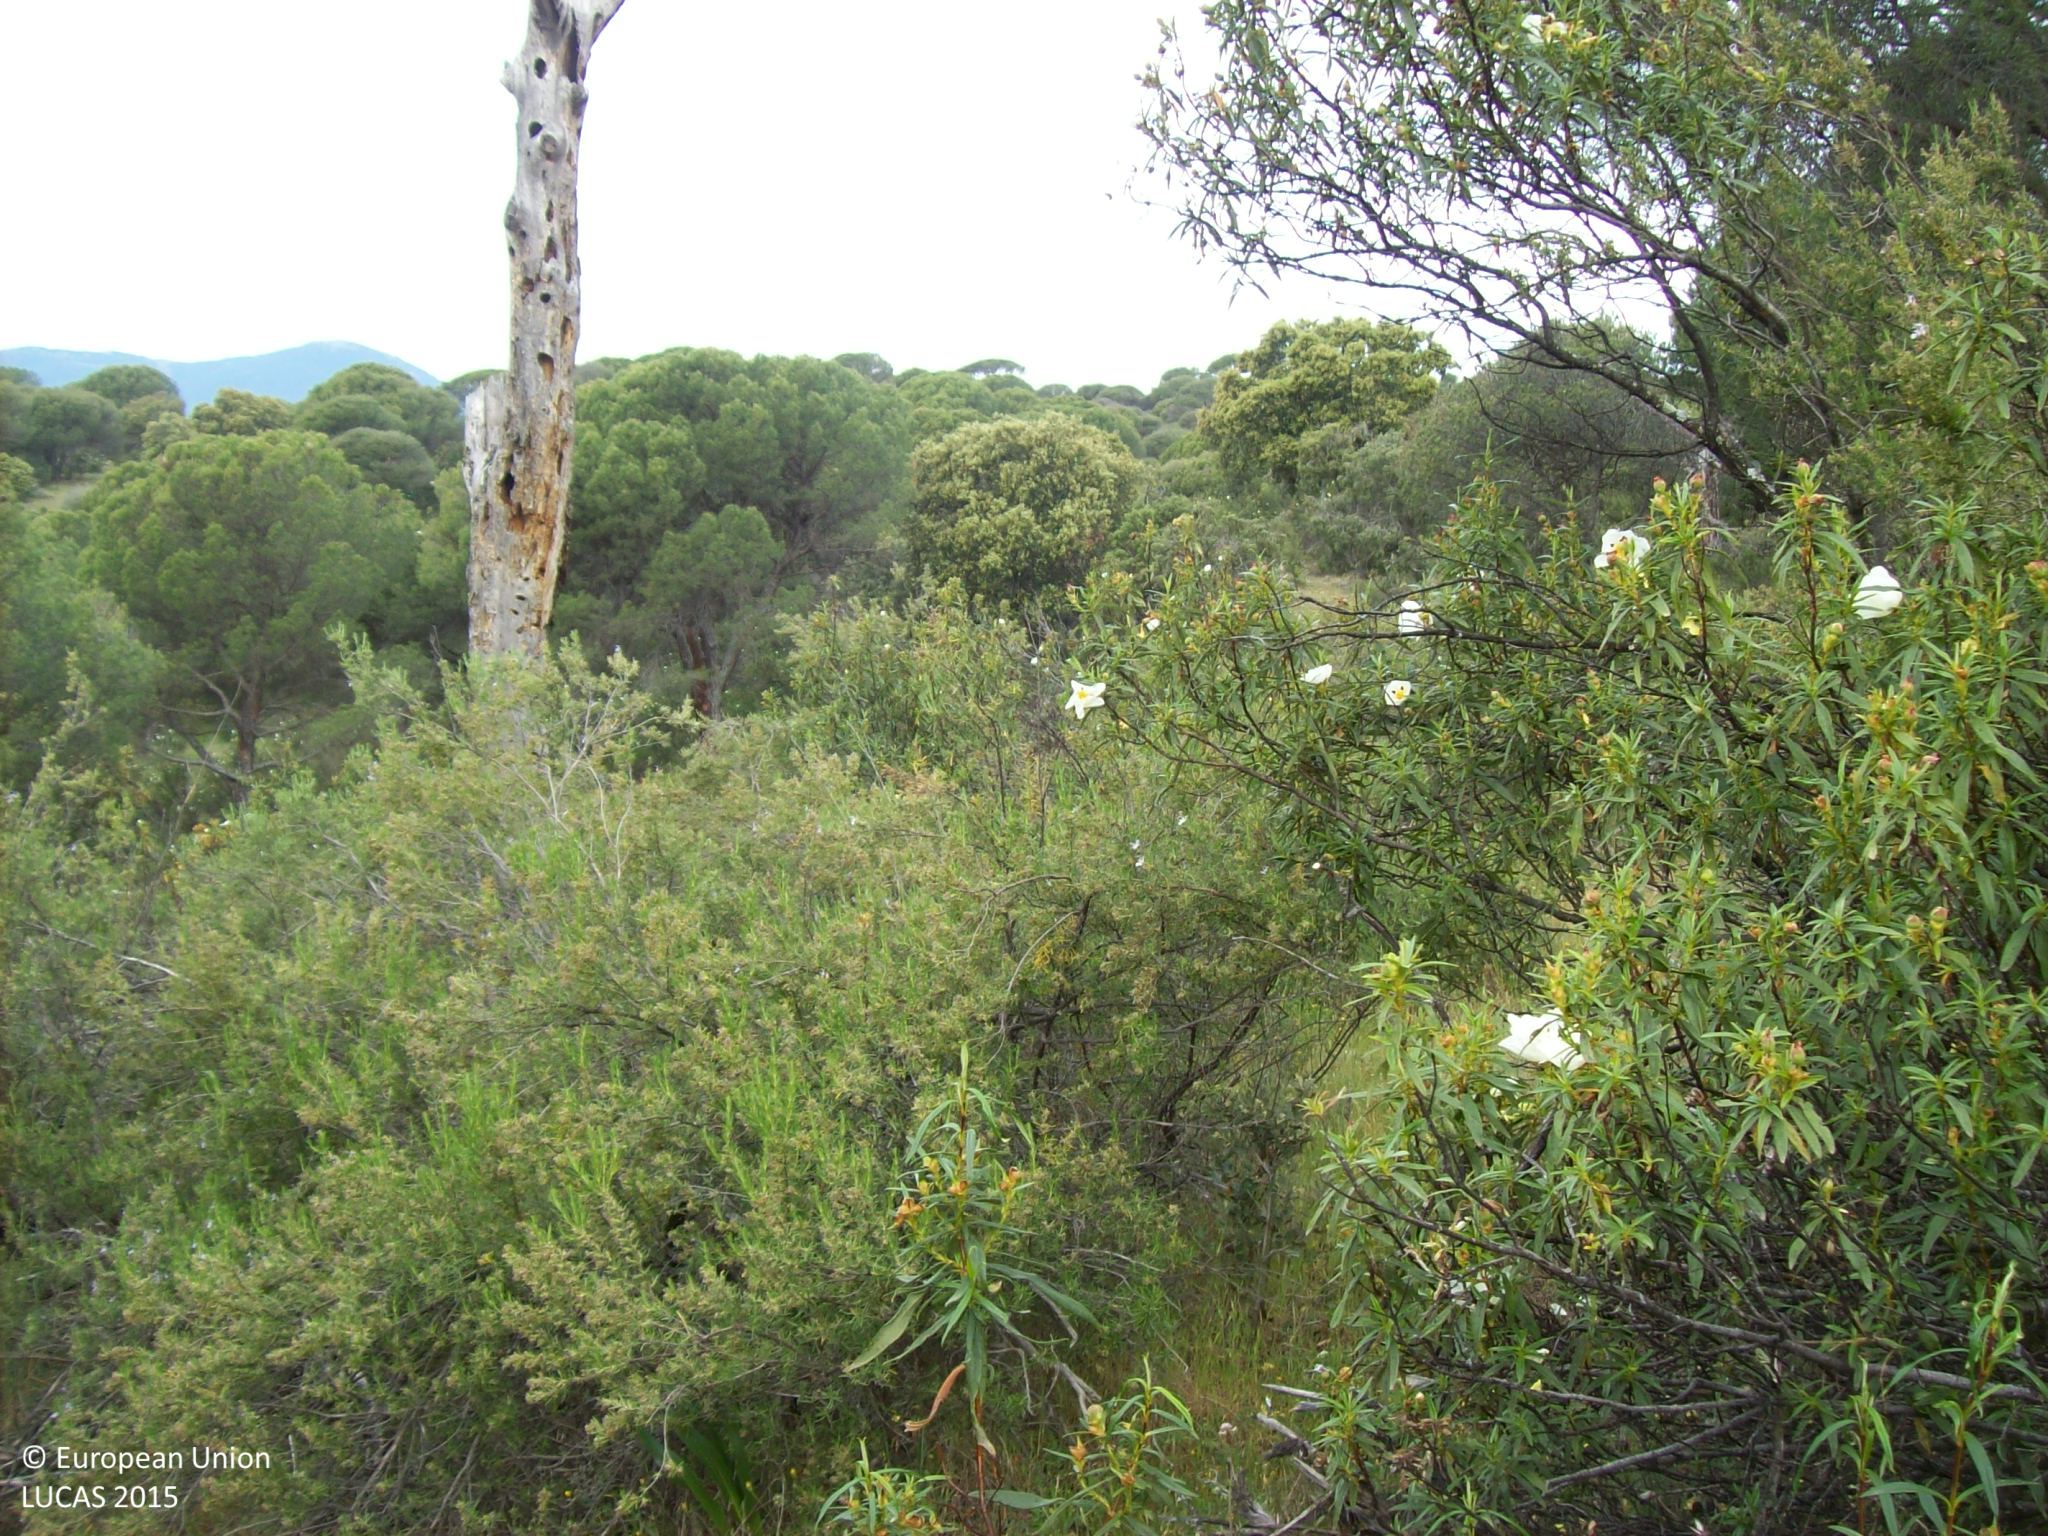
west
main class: Woodland
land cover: Pine dominated coniferous woodland
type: coniferous forest of the mediterranean region
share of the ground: 25 - 50 %
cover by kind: shrubs 40 %, herbaceous plants 35 %, coniferous forest trees 25 %
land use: Sport
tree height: > 5 m
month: April
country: ES
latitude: 40.4288
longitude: -4.3927
